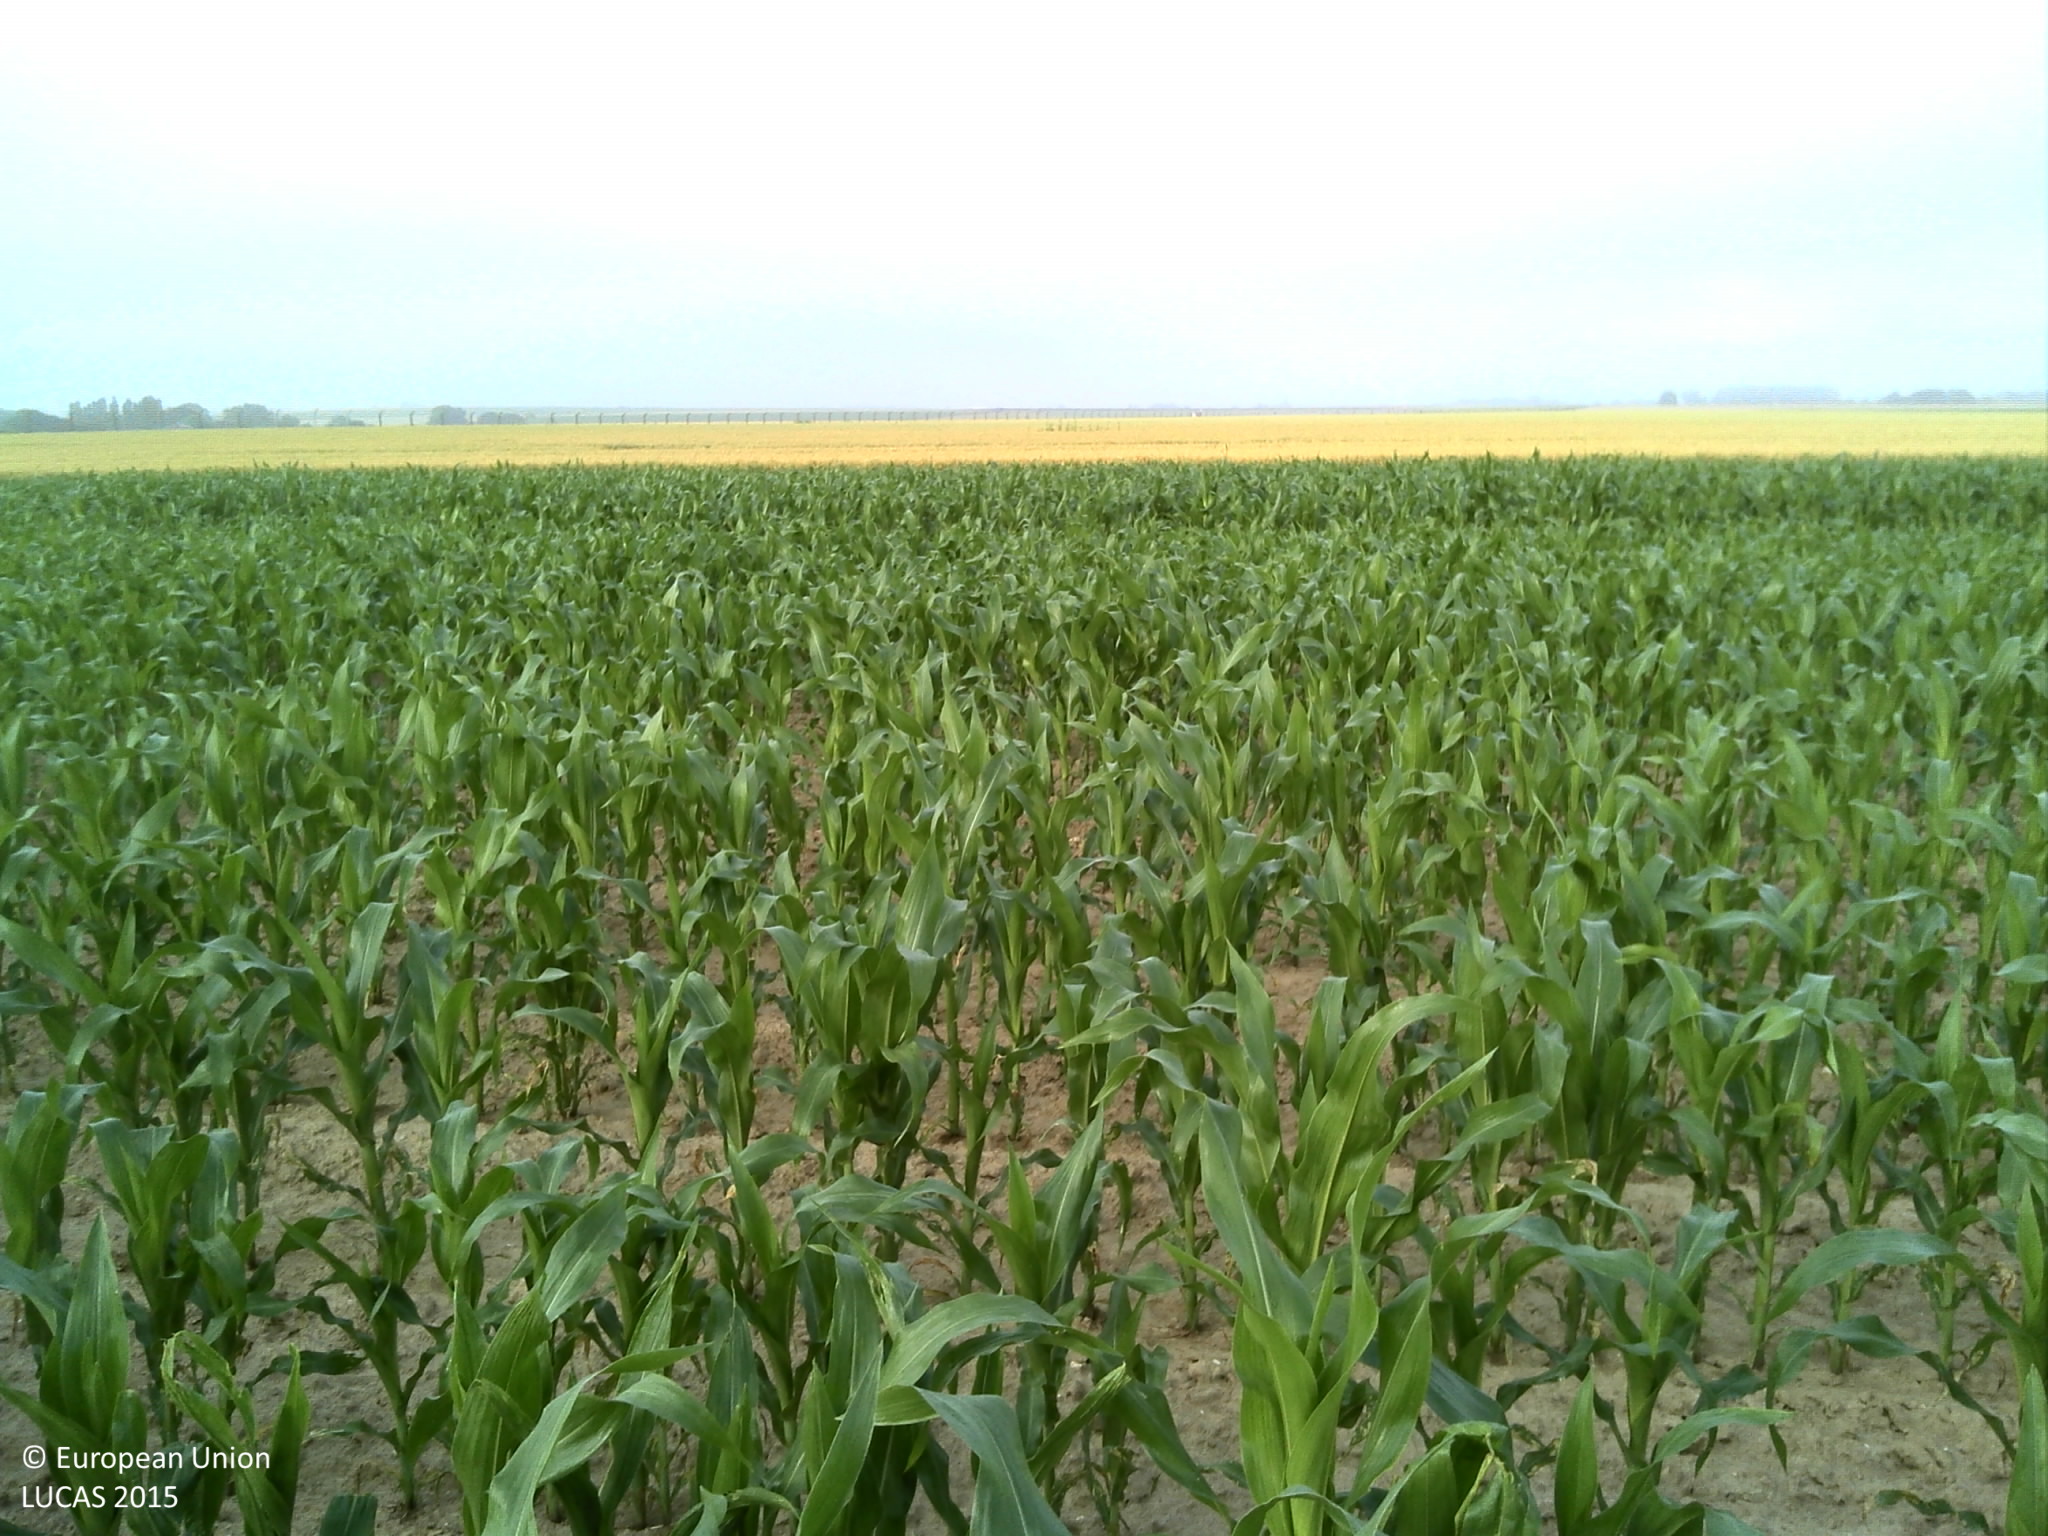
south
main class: Cropland
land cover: Maize
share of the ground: 50 - 75 %
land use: Agriculture (excluding fallow land and kitchen gardens)
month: July
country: FR
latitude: 49.3893
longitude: 1.1758
